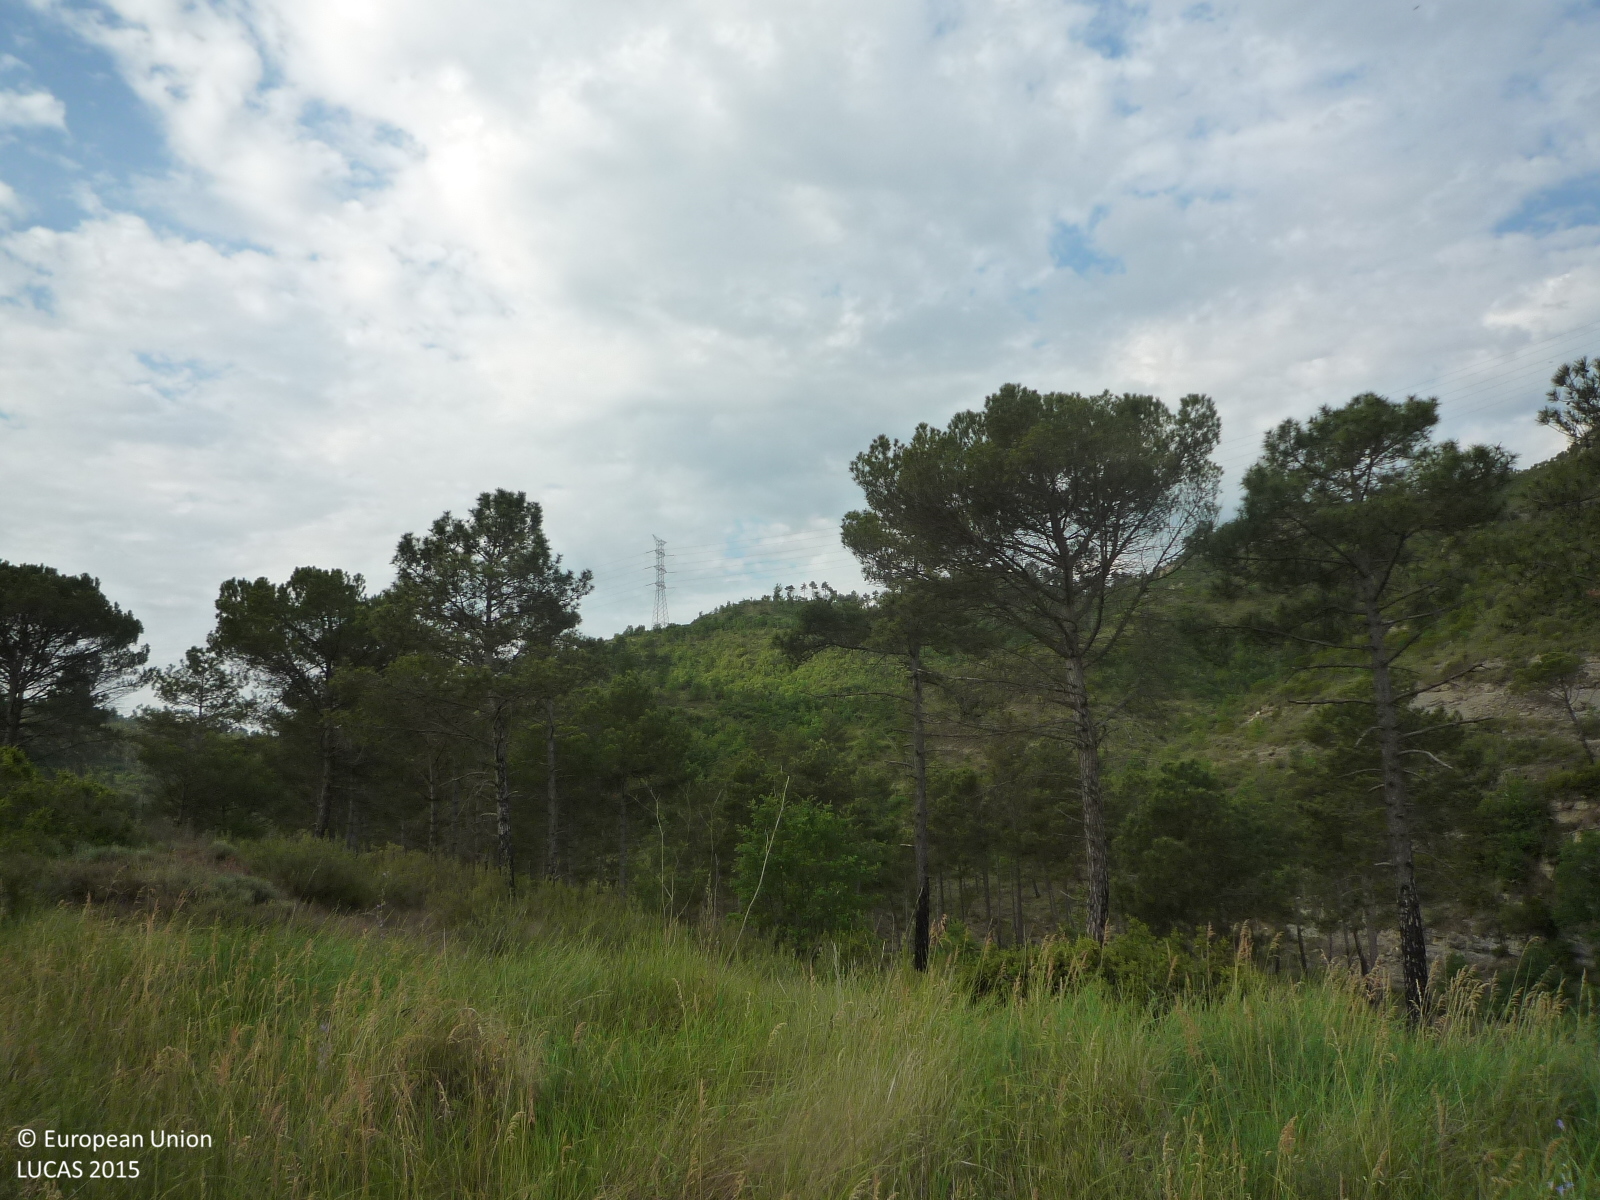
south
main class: Grassland
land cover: Grassland with sparse tree/shrub cover
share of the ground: > 75 %
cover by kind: herbaceous plants 95 %, coniferous forest trees 5 %
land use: Semi-natural and natural areas not in use
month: June
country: ES
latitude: 41.7400
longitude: 2.0196
